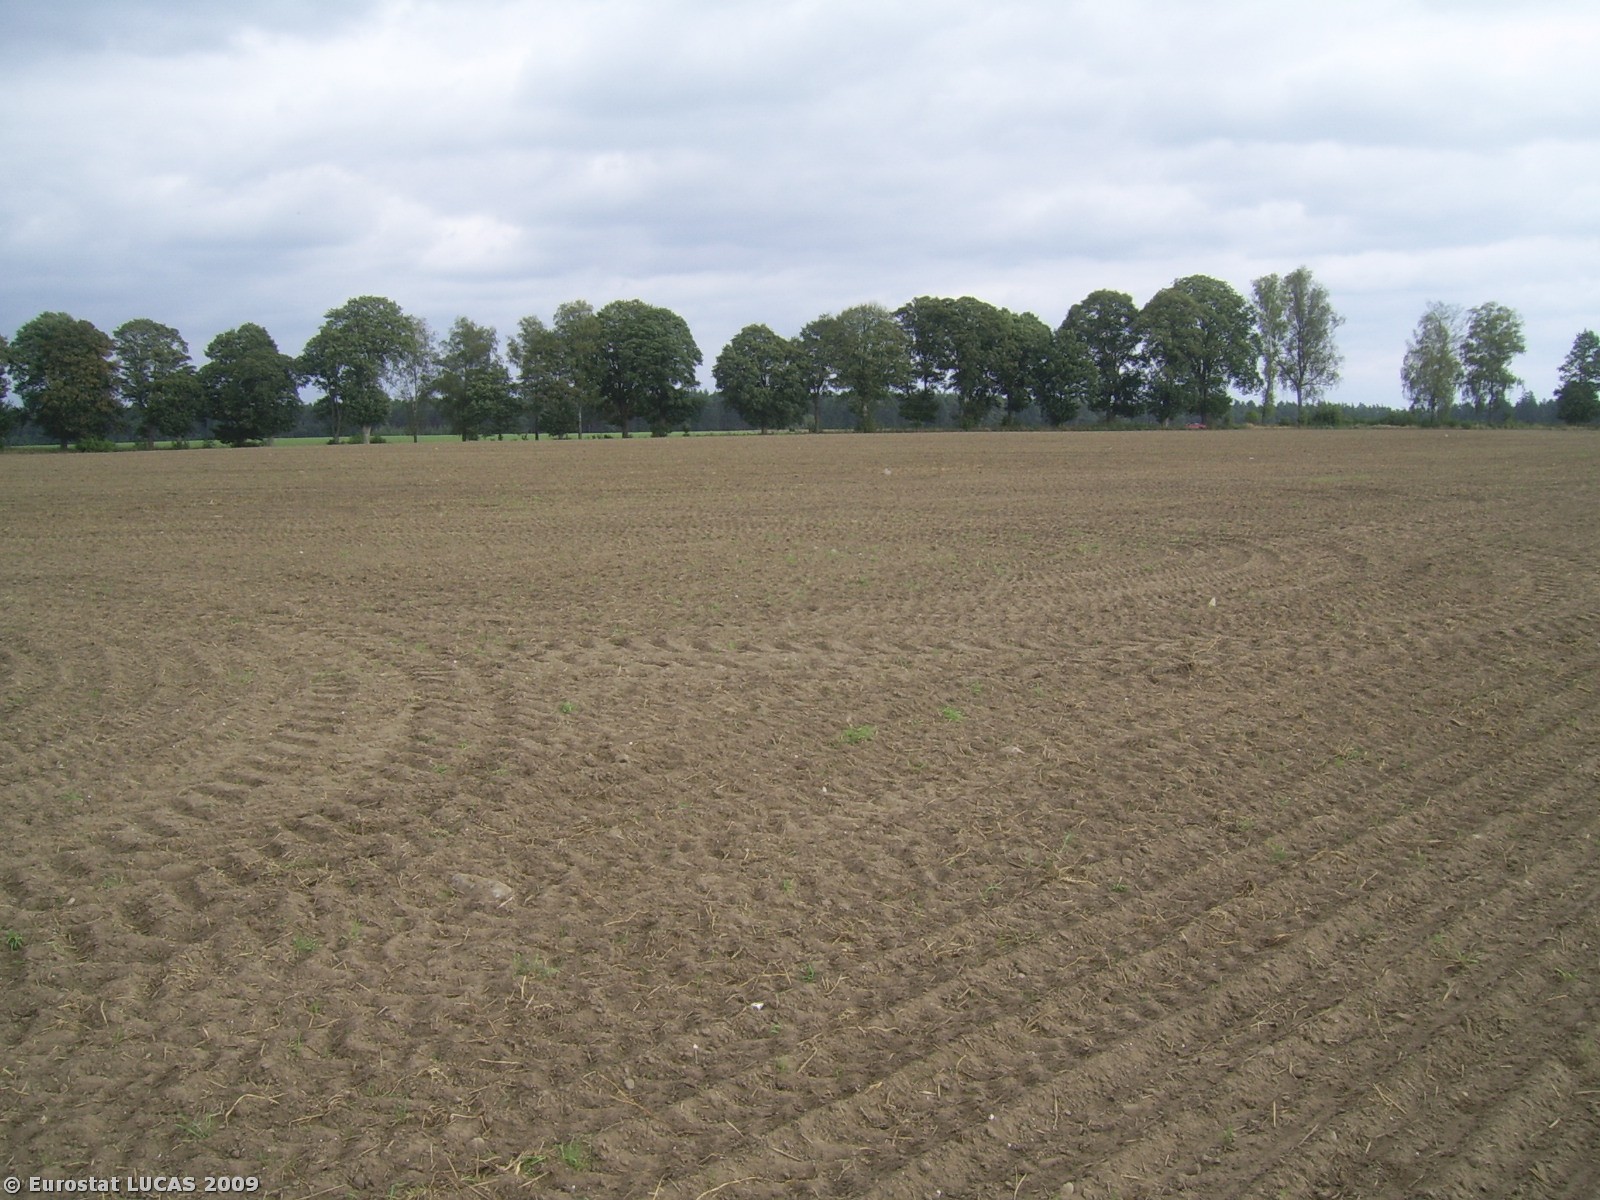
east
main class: Cropland
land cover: Rape and turnip rape
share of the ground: < 10 %
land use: Agriculture (excluding fallow land and kitchen gardens)
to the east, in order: Rape and turnip rape
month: September
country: PL
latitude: 53.8292
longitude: 16.3720
